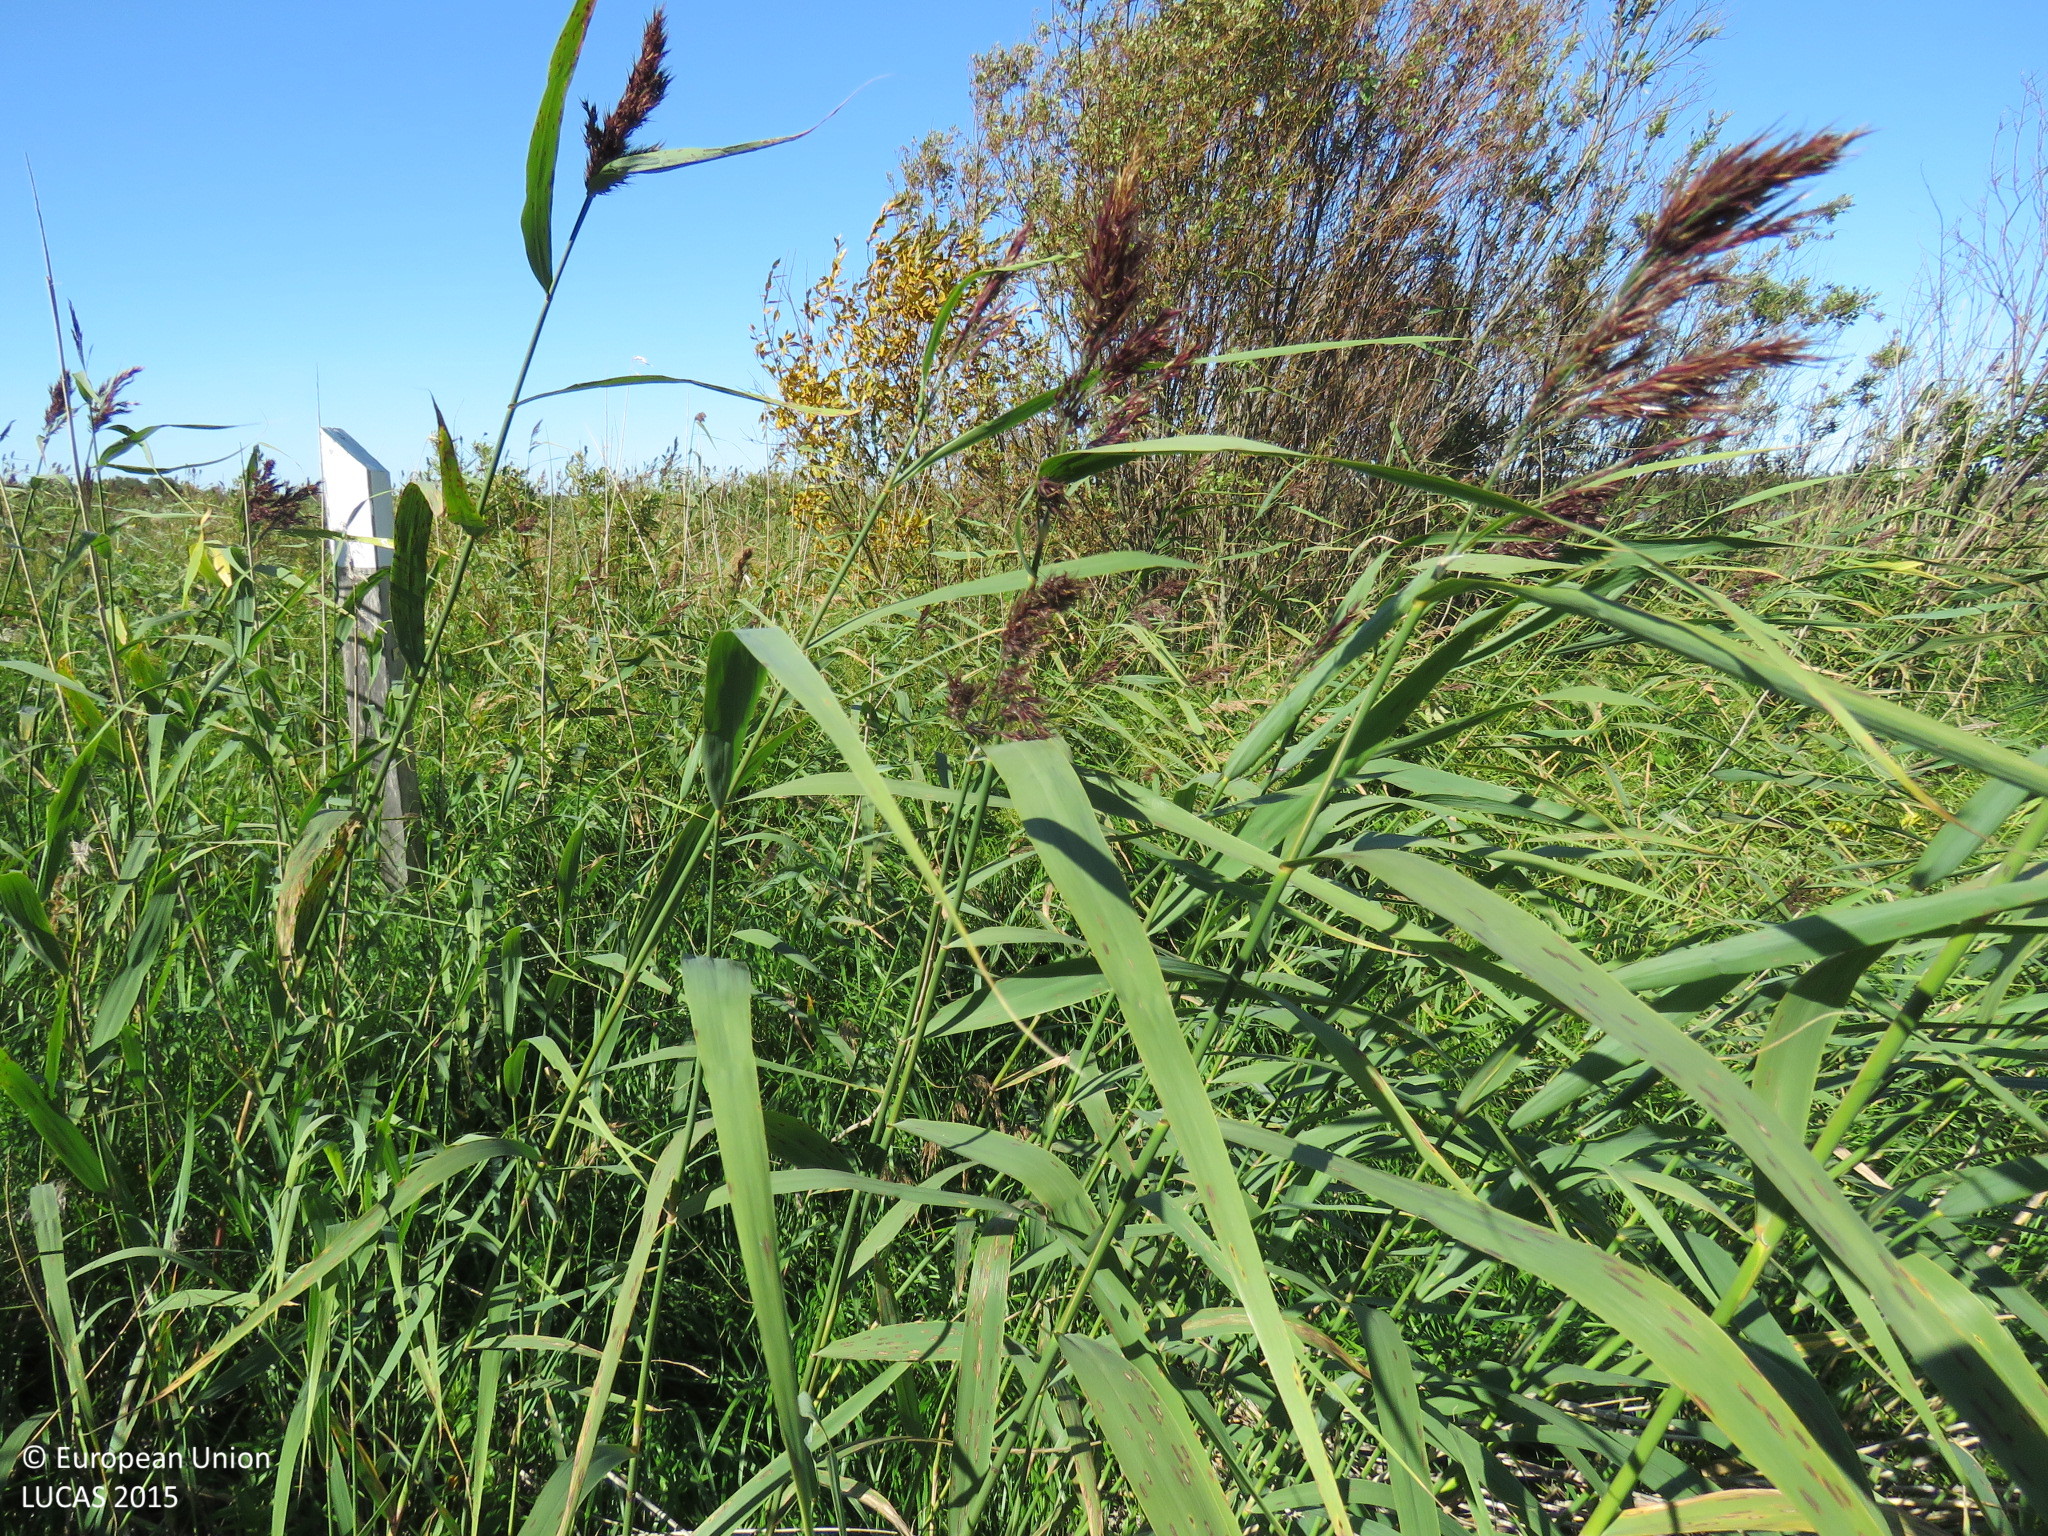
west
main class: Grassland
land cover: Grassland without tree/shrub cover
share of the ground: > 75 %
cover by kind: herbaceous plants 95 %, shrubs 5 %
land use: Semi-natural and natural areas not in use
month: August
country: FI
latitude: 64.9766
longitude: 24.7518
